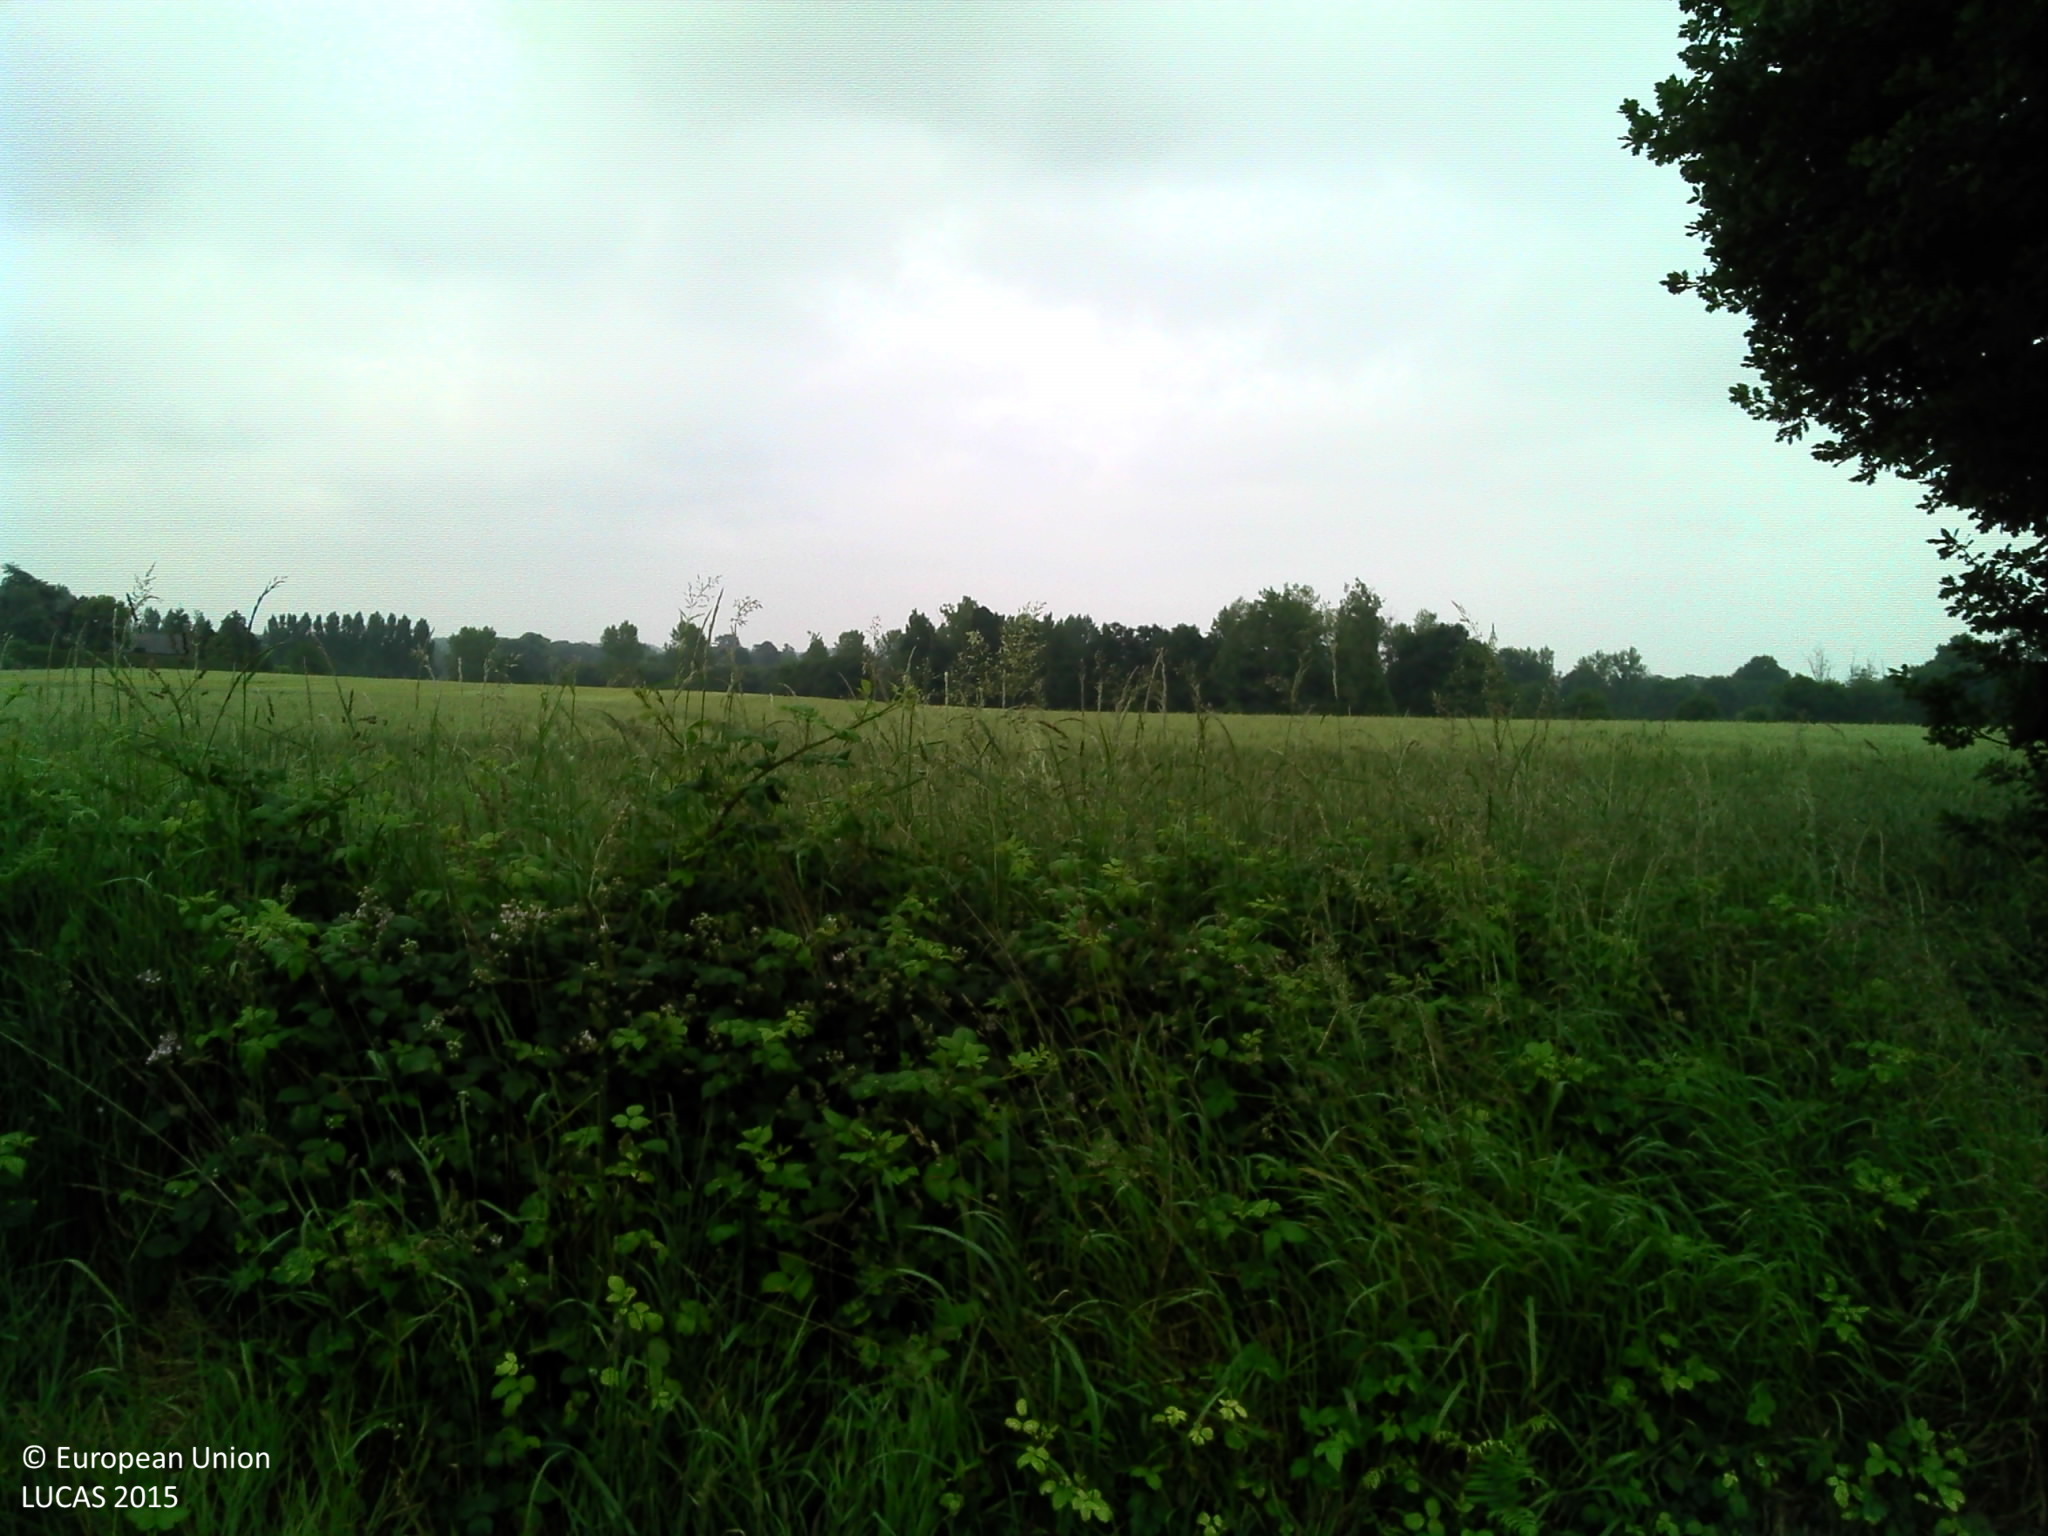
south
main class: Cropland
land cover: Maize
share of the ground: 10 - 25 %
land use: Agriculture (excluding fallow land and kitchen gardens)
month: June
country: FR
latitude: 48.4037
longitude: -1.8167
